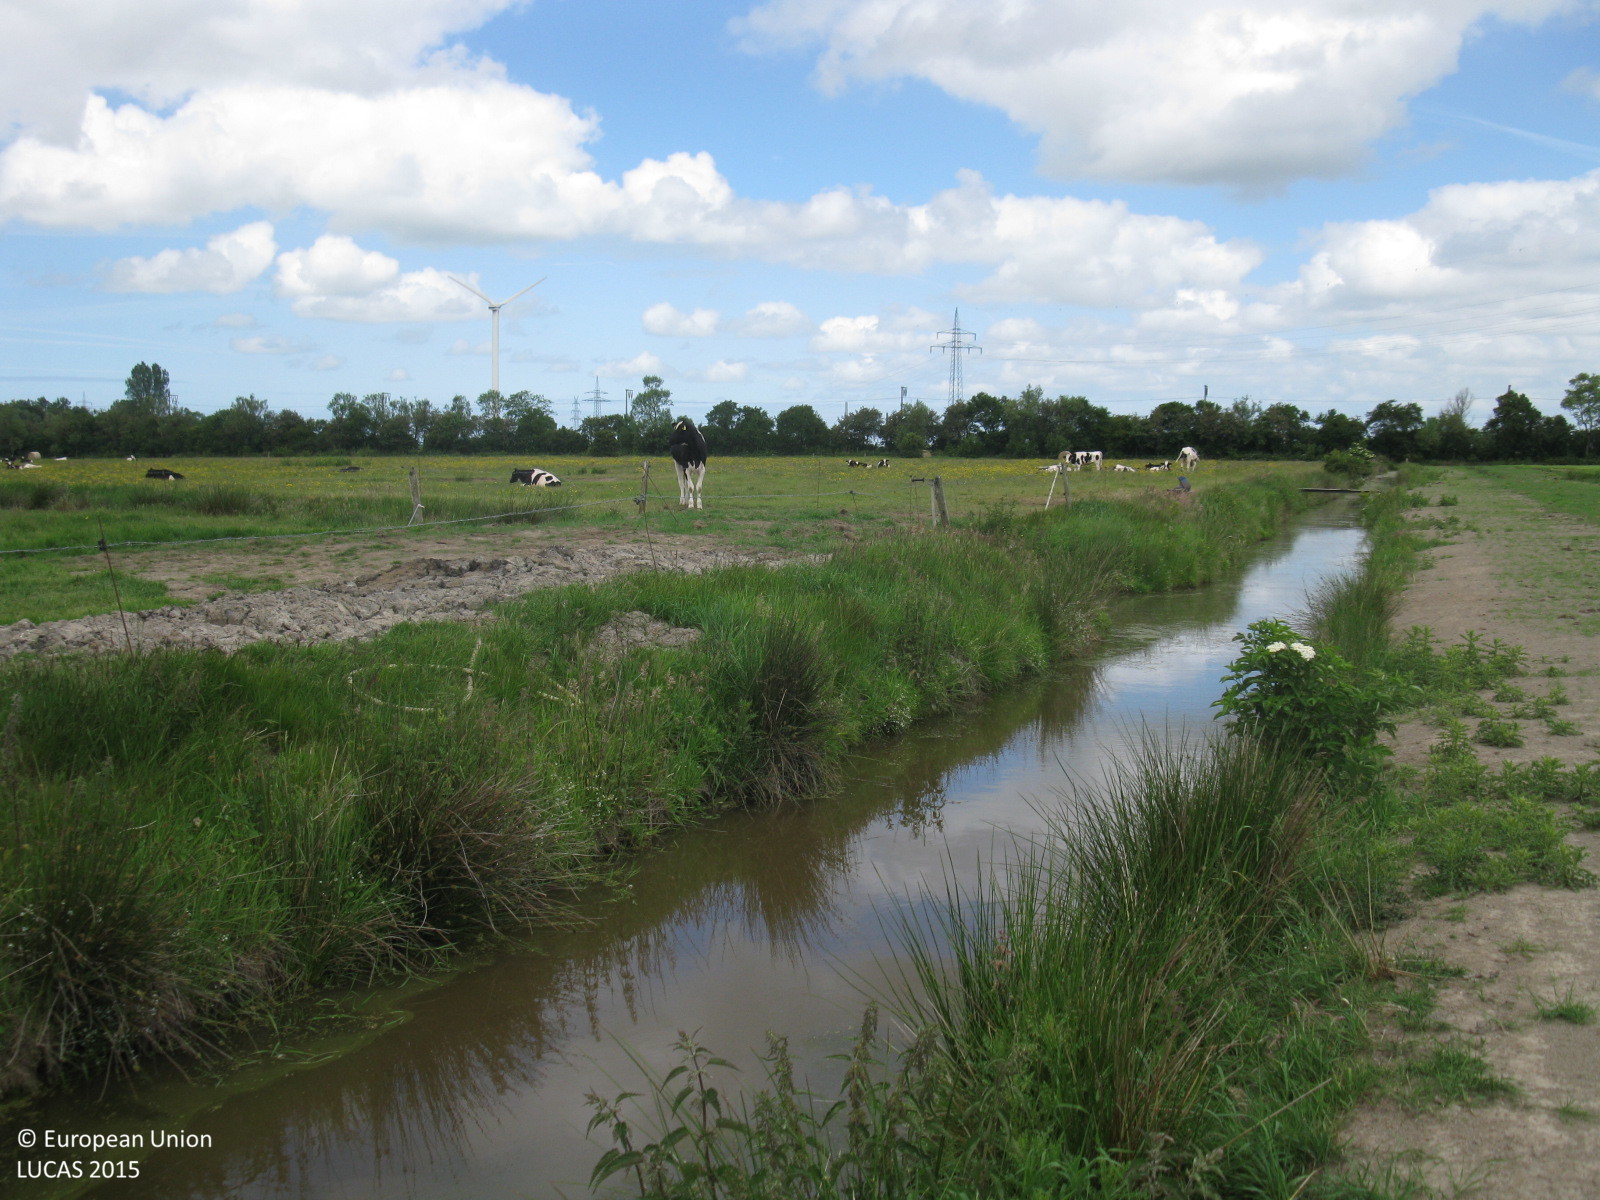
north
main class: Grassland
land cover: Grassland without tree/shrub cover
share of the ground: > 75 %
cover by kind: herbaceous plants 100 %
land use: Agriculture (excluding fallow land and kitchen gardens)
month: June
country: DE
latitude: 53.3355
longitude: 7.2824
